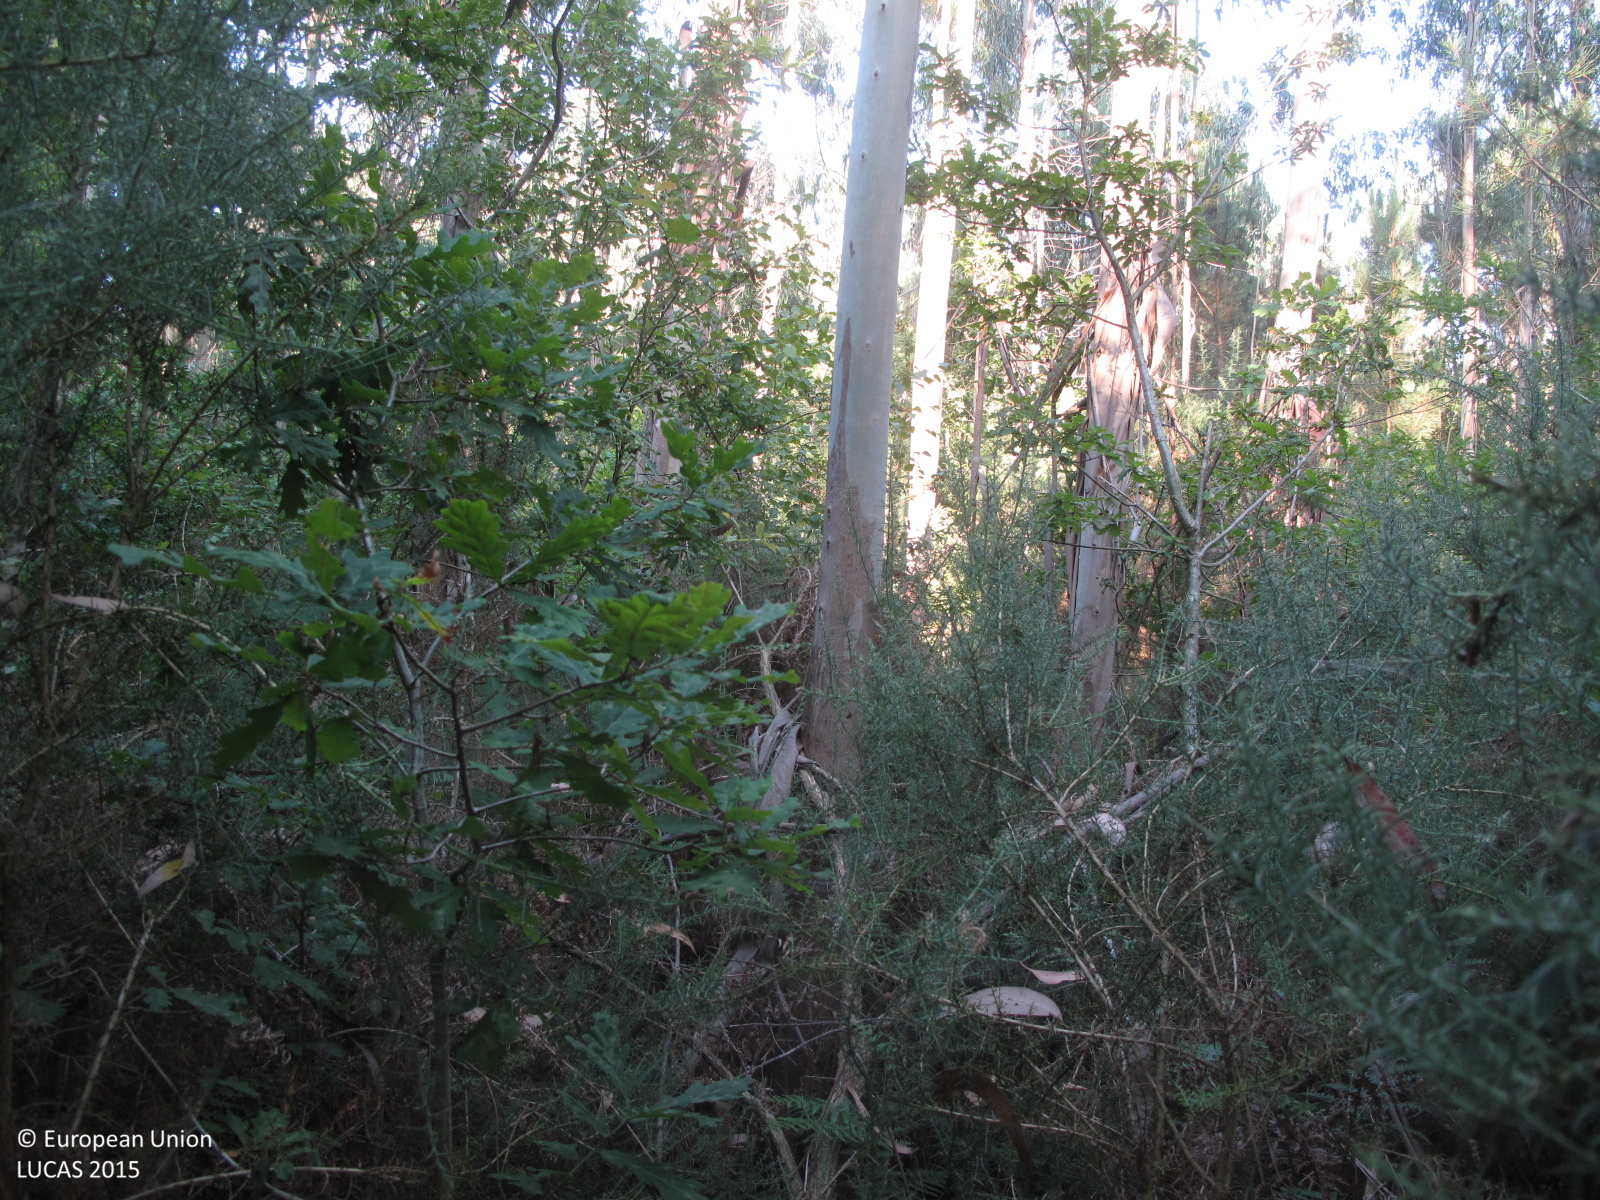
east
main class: Woodland
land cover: Broadleaved woodland
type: acidophilous oak and oak-birch forest
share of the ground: > 75 %
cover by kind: broadleaved forest trees 90 %, shrubs 5 %, herbaceous plants 5 %
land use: Forestry
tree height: > 5 m
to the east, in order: Broadleaved woodland; Other mixed woodland; Tracks; Grassland without tree/shrub cover; Pine dominated coniferous woodland; Broadleaved woodland; Shrubland without tree cover; Electric lines
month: July
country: ES
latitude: 43.3255
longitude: -8.0382
